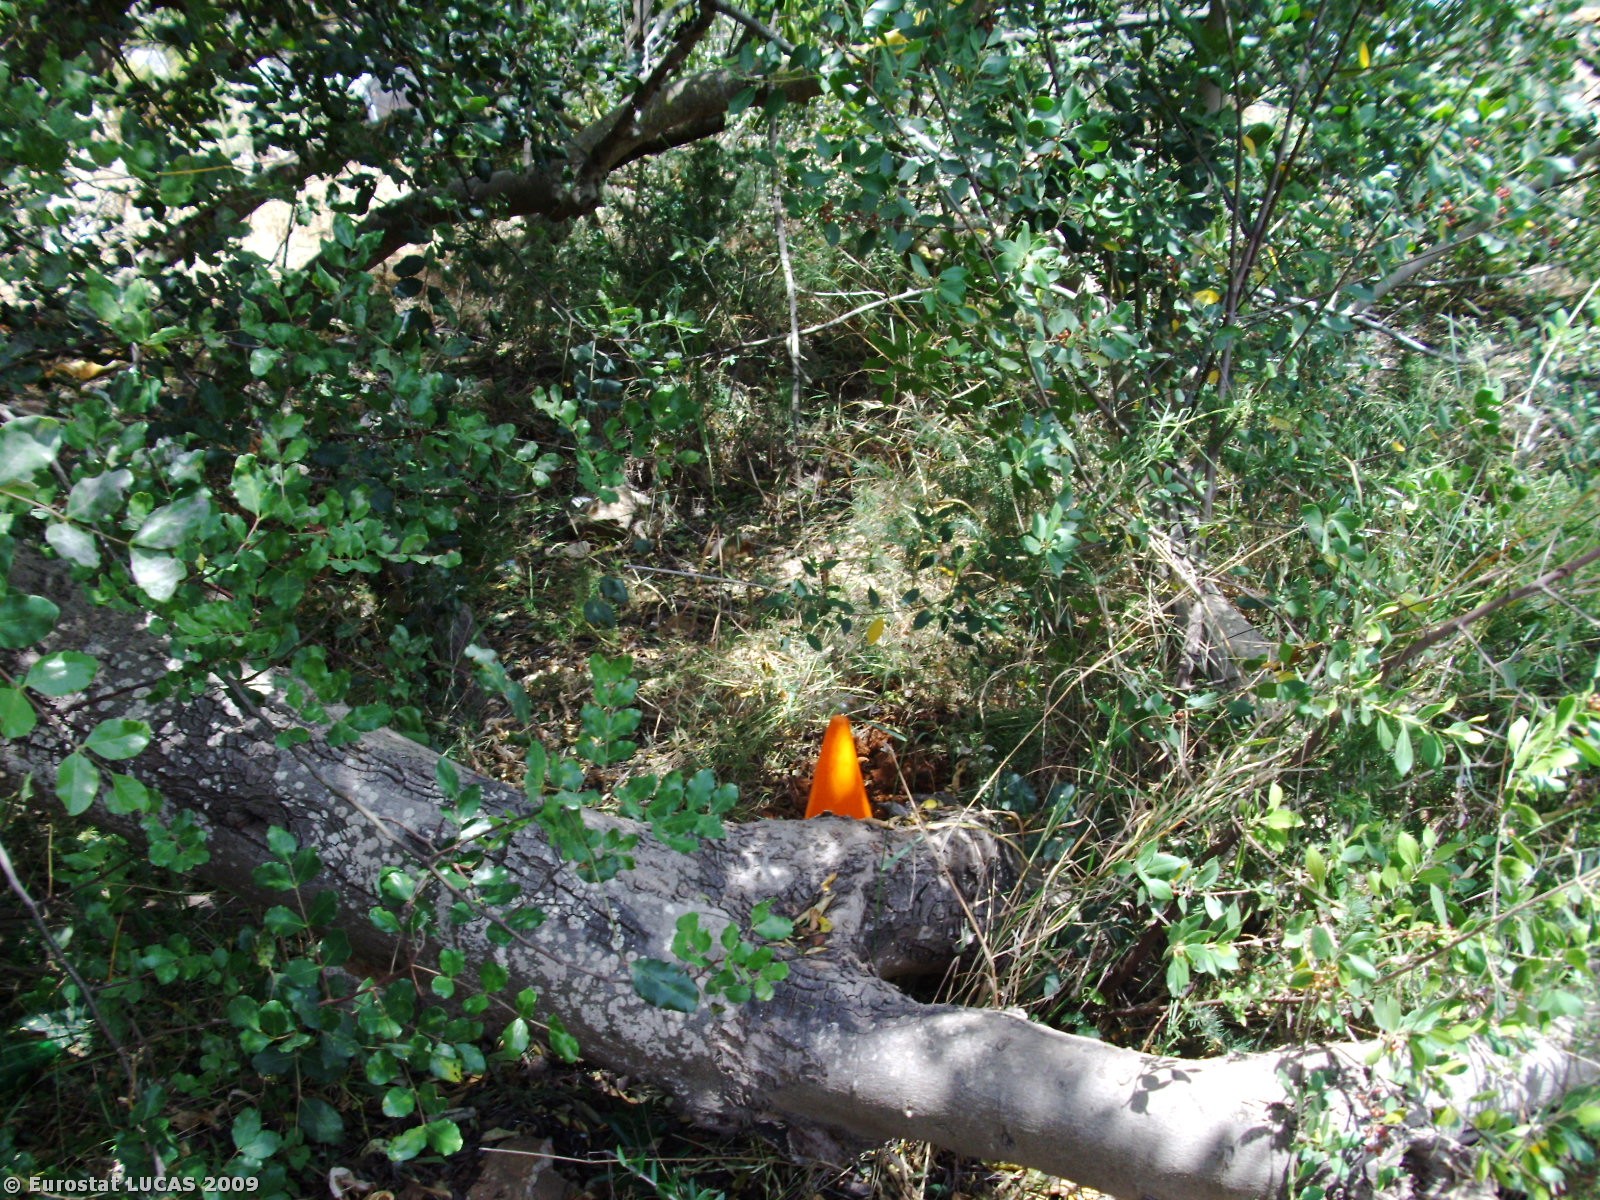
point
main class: Cropland
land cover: Permanent industrial crops
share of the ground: 25 - 50 %
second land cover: Spontaneously vegetated surfaces
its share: 50 - 75 %
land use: Fallow land
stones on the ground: < 10 %
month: May
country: PT
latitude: 37.1610
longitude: -8.4810
